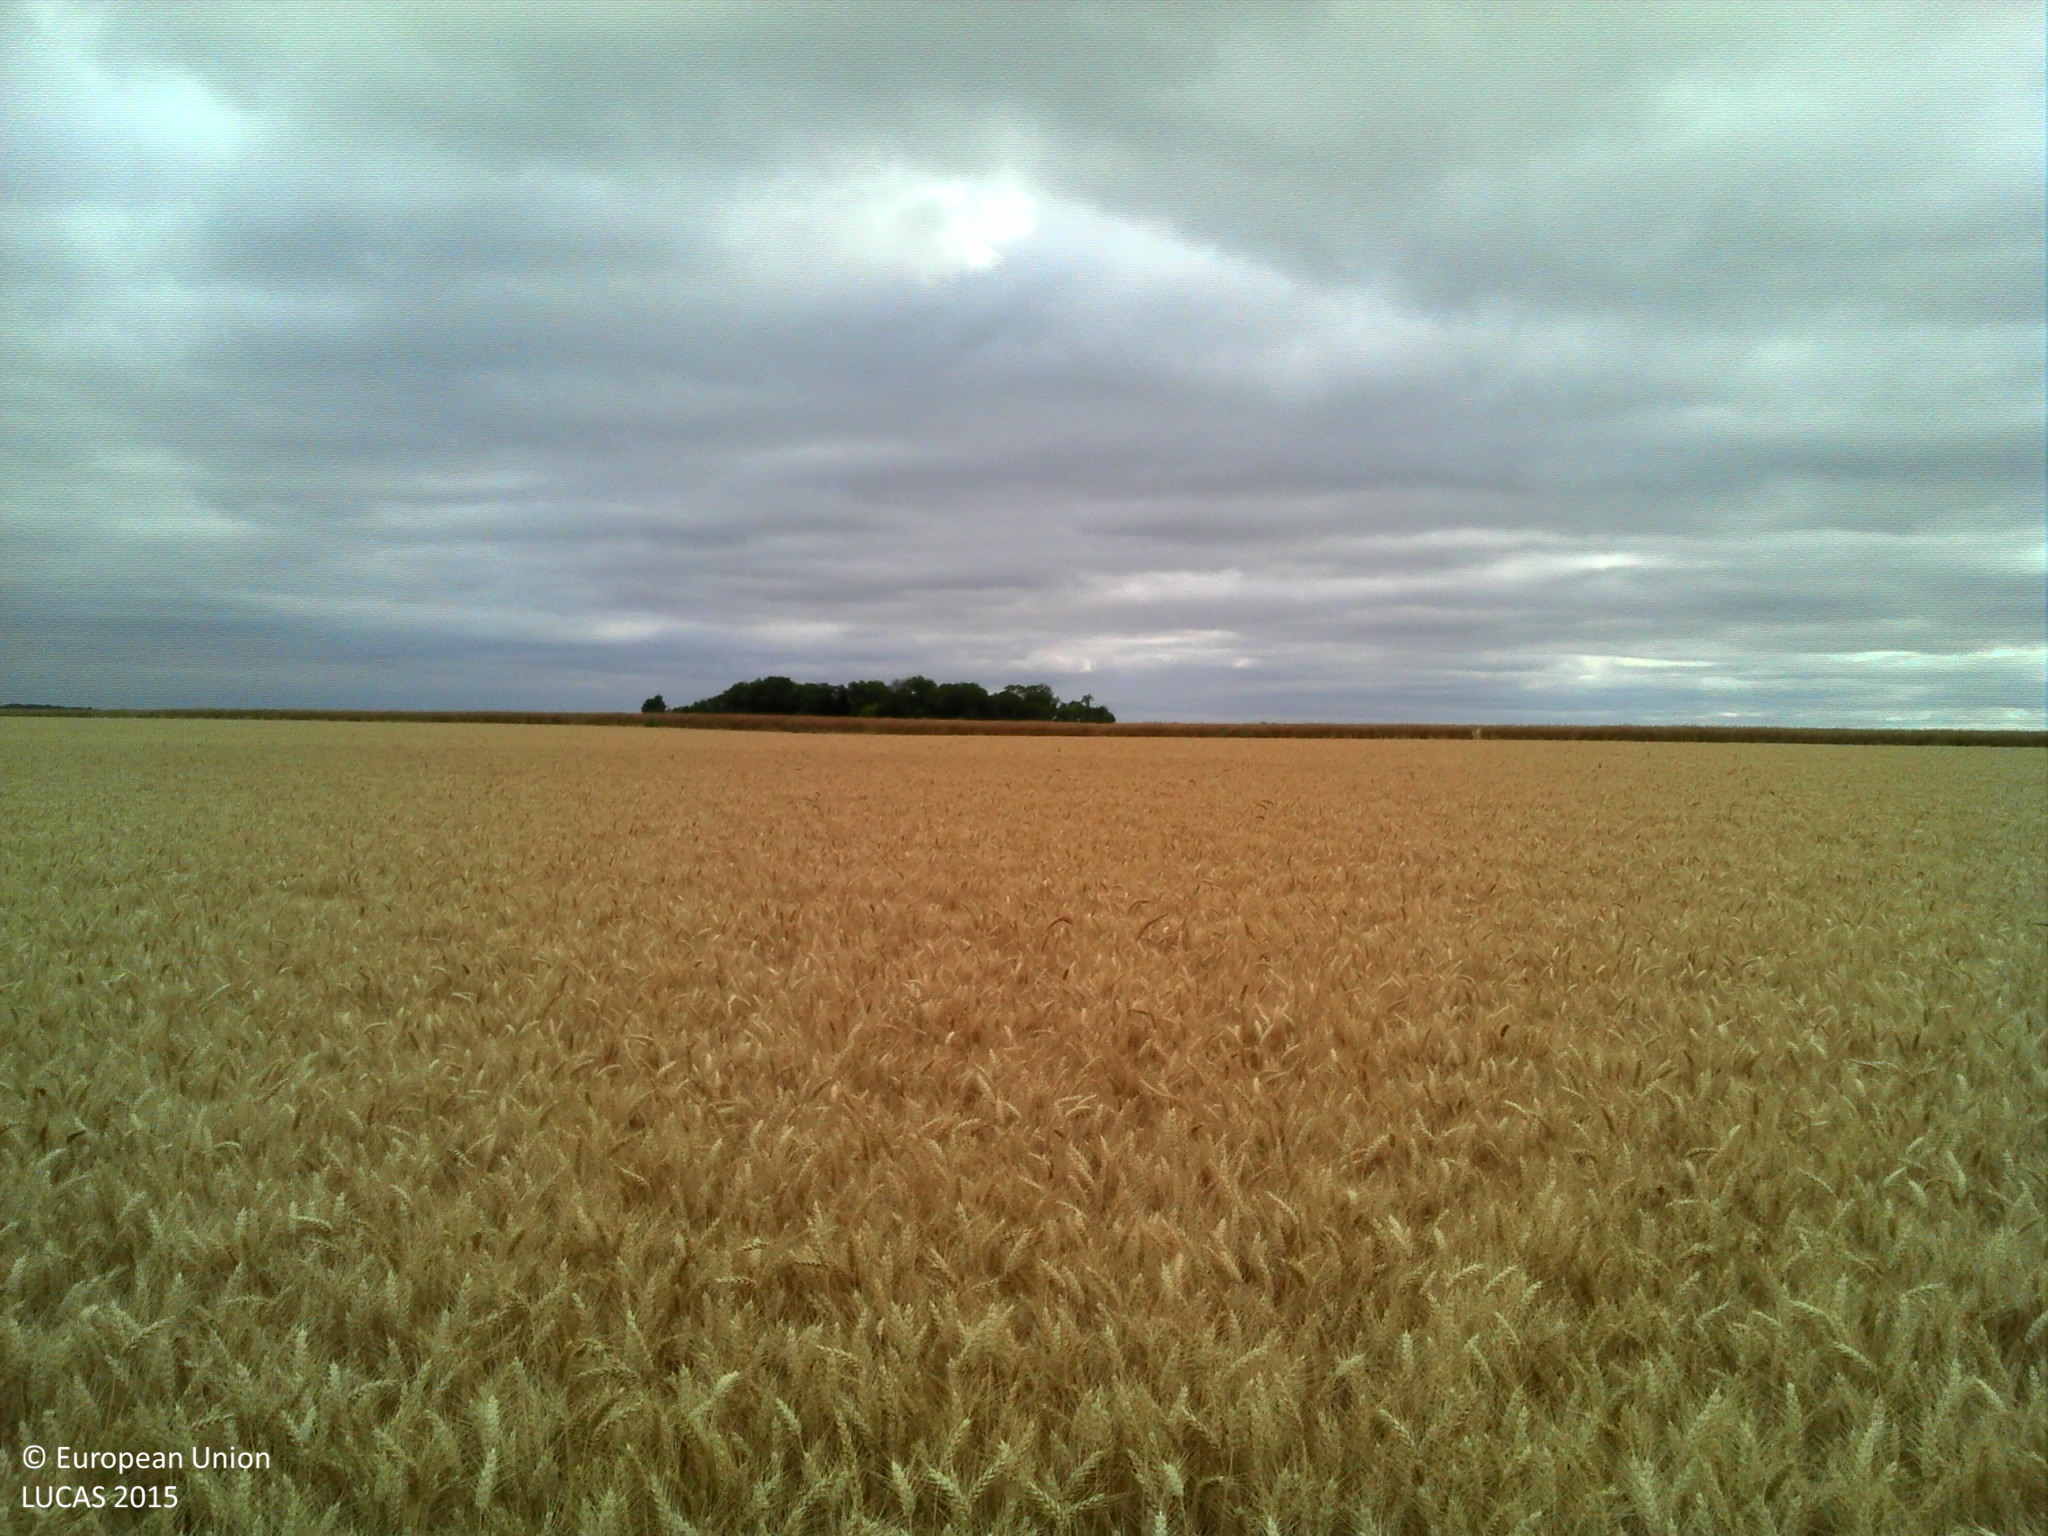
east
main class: Cropland
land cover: Common wheat
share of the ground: > 75 %
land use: Agriculture (excluding fallow land and kitchen gardens)
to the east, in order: Common wheat; Ditches and canals; Tracks; Rape and turnip rape
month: July
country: FR
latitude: 49.3252
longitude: 2.2681
